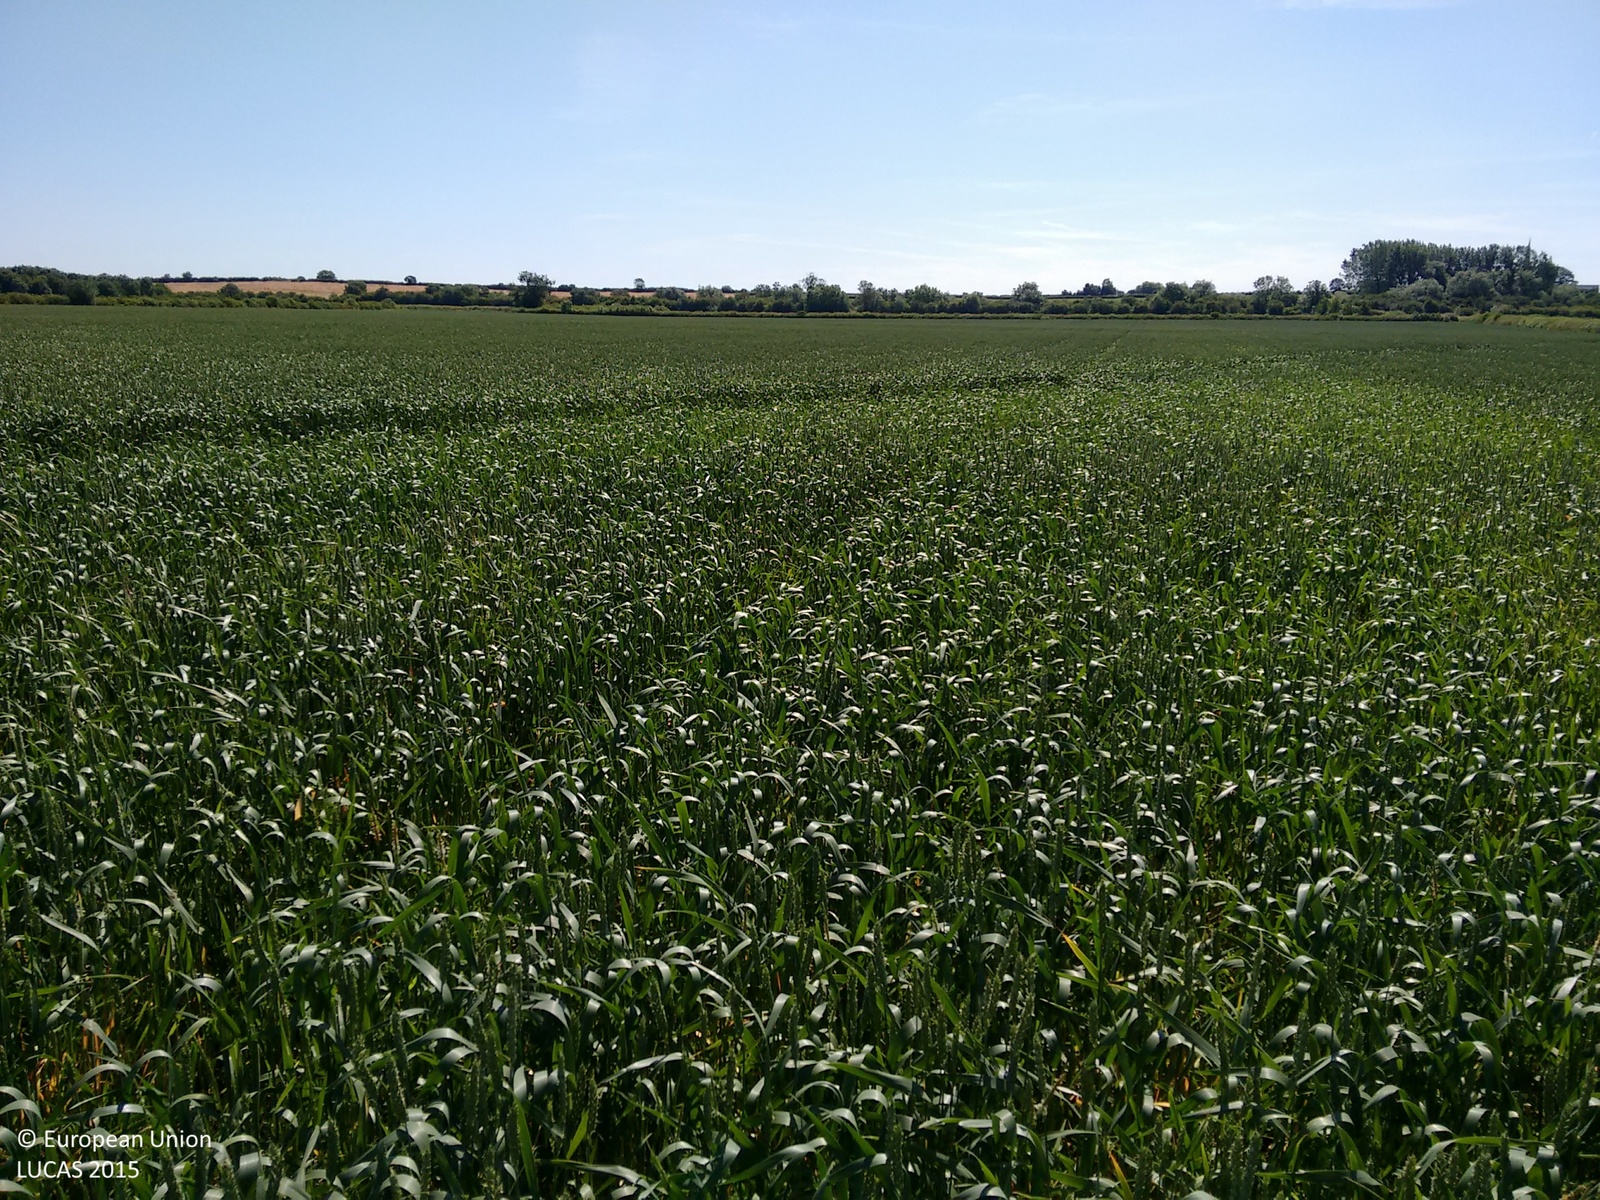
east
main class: Cropland
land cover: Common wheat
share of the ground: > 75 %
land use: Agriculture (excluding fallow land and kitchen gardens)
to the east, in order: Common wheat
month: July
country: GB
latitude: 52.9126
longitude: -0.8530
